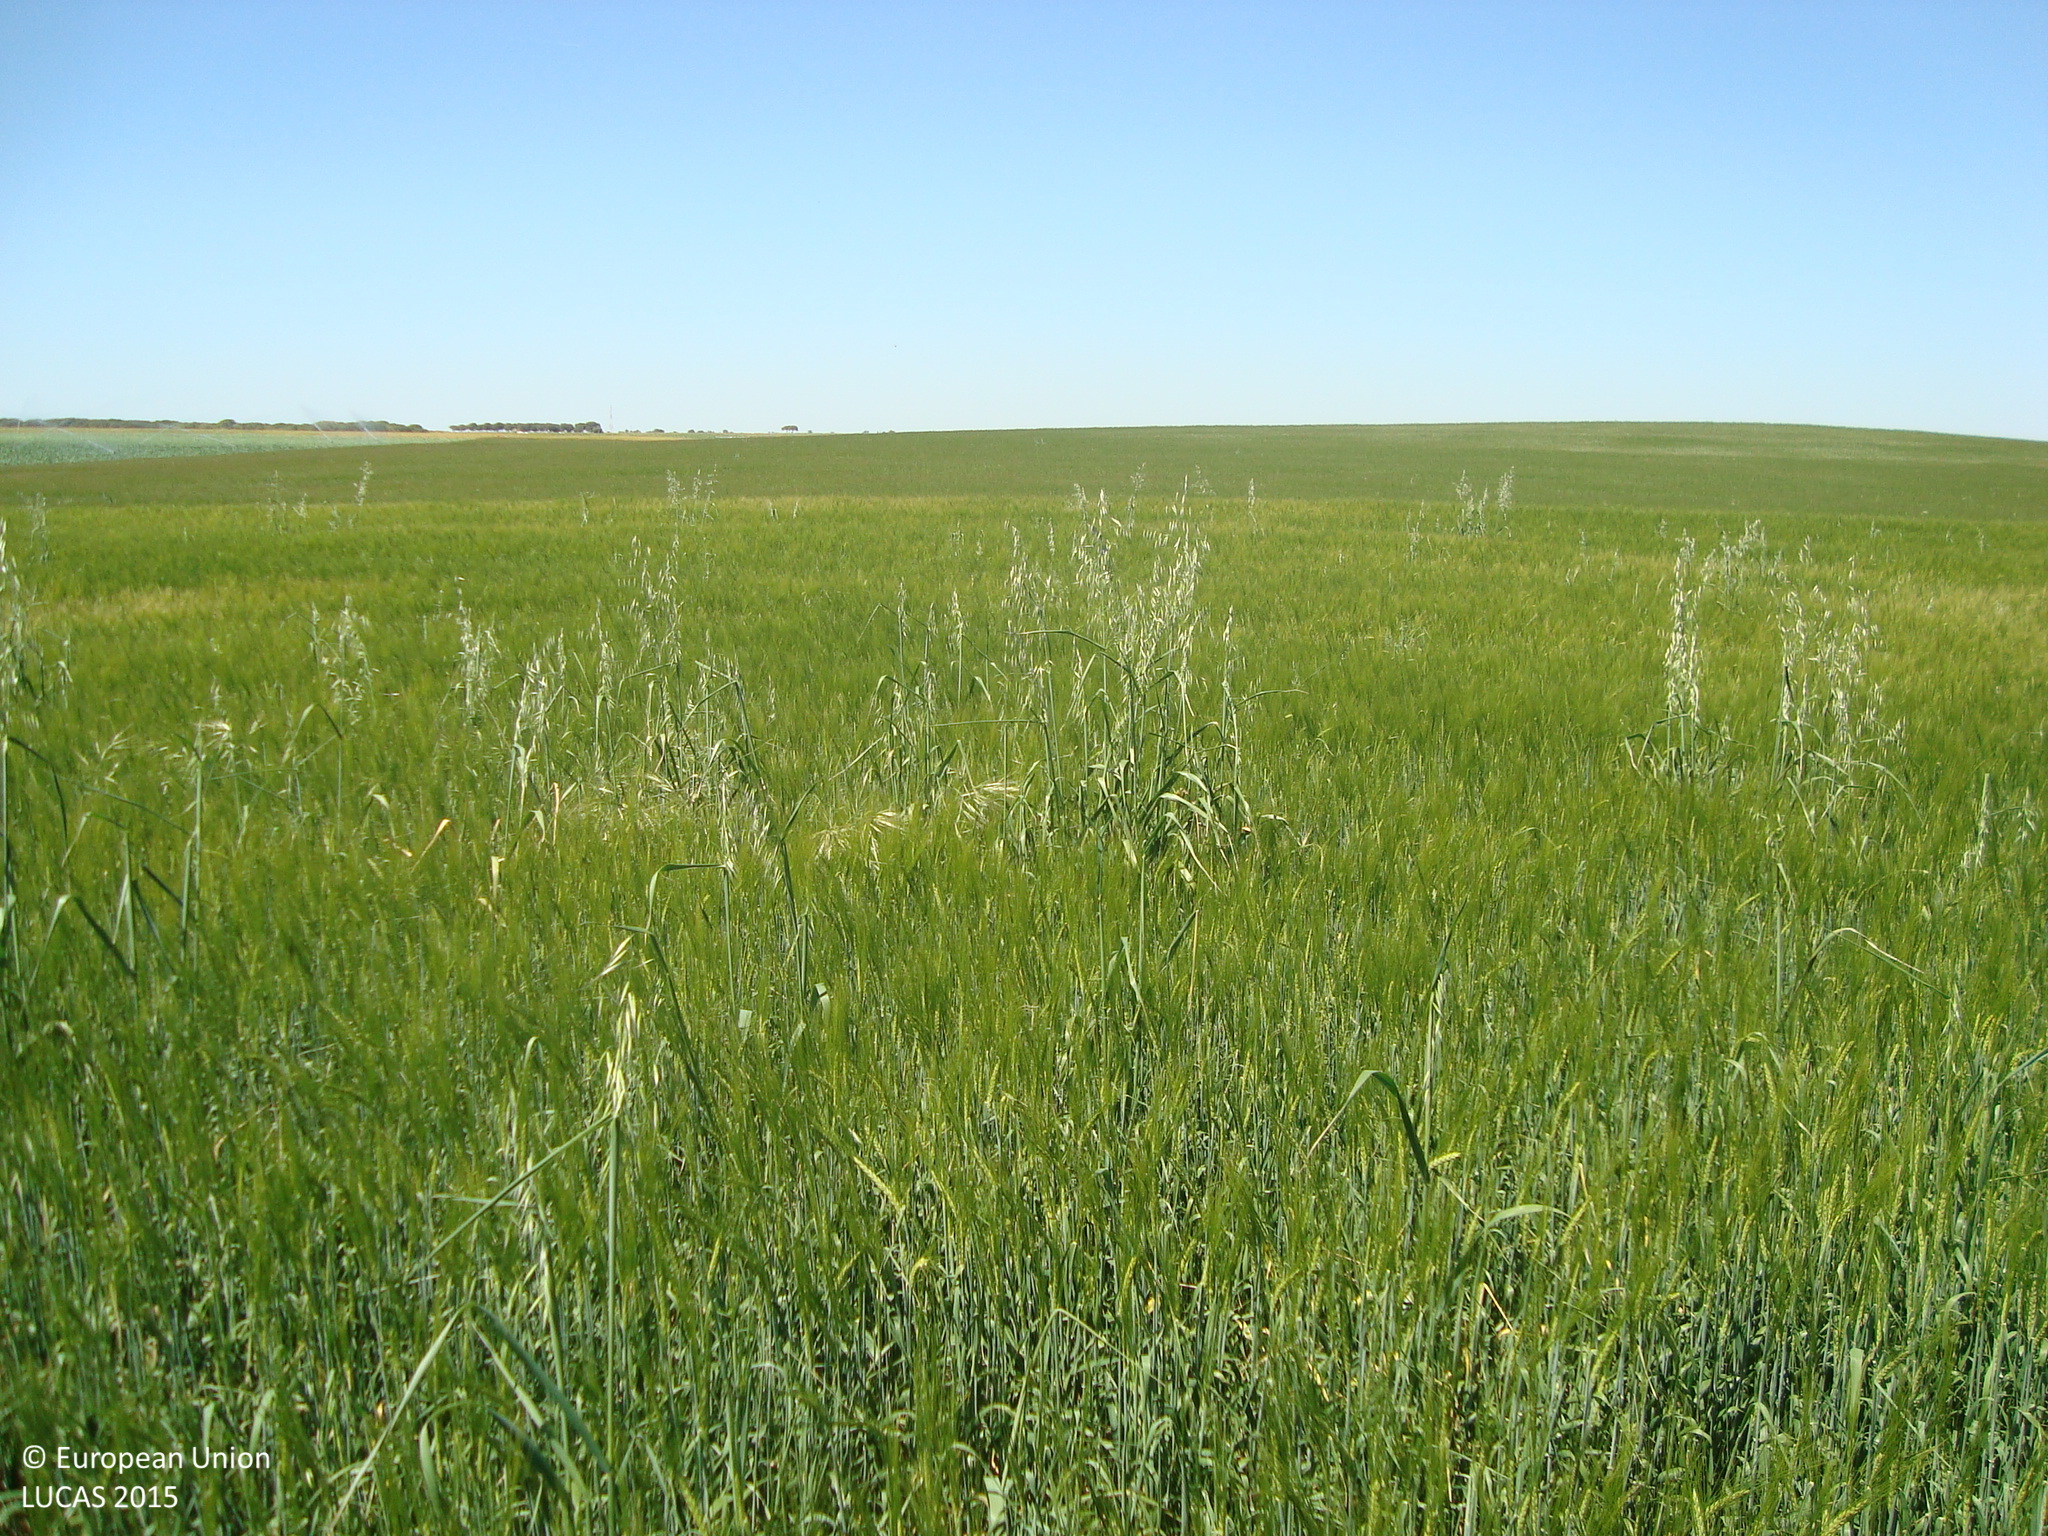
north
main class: Cropland
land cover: Barley
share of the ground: > 75 %
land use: Agriculture (excluding fallow land and kitchen gardens)
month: May
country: ES
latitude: 41.4751
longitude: -4.1275
